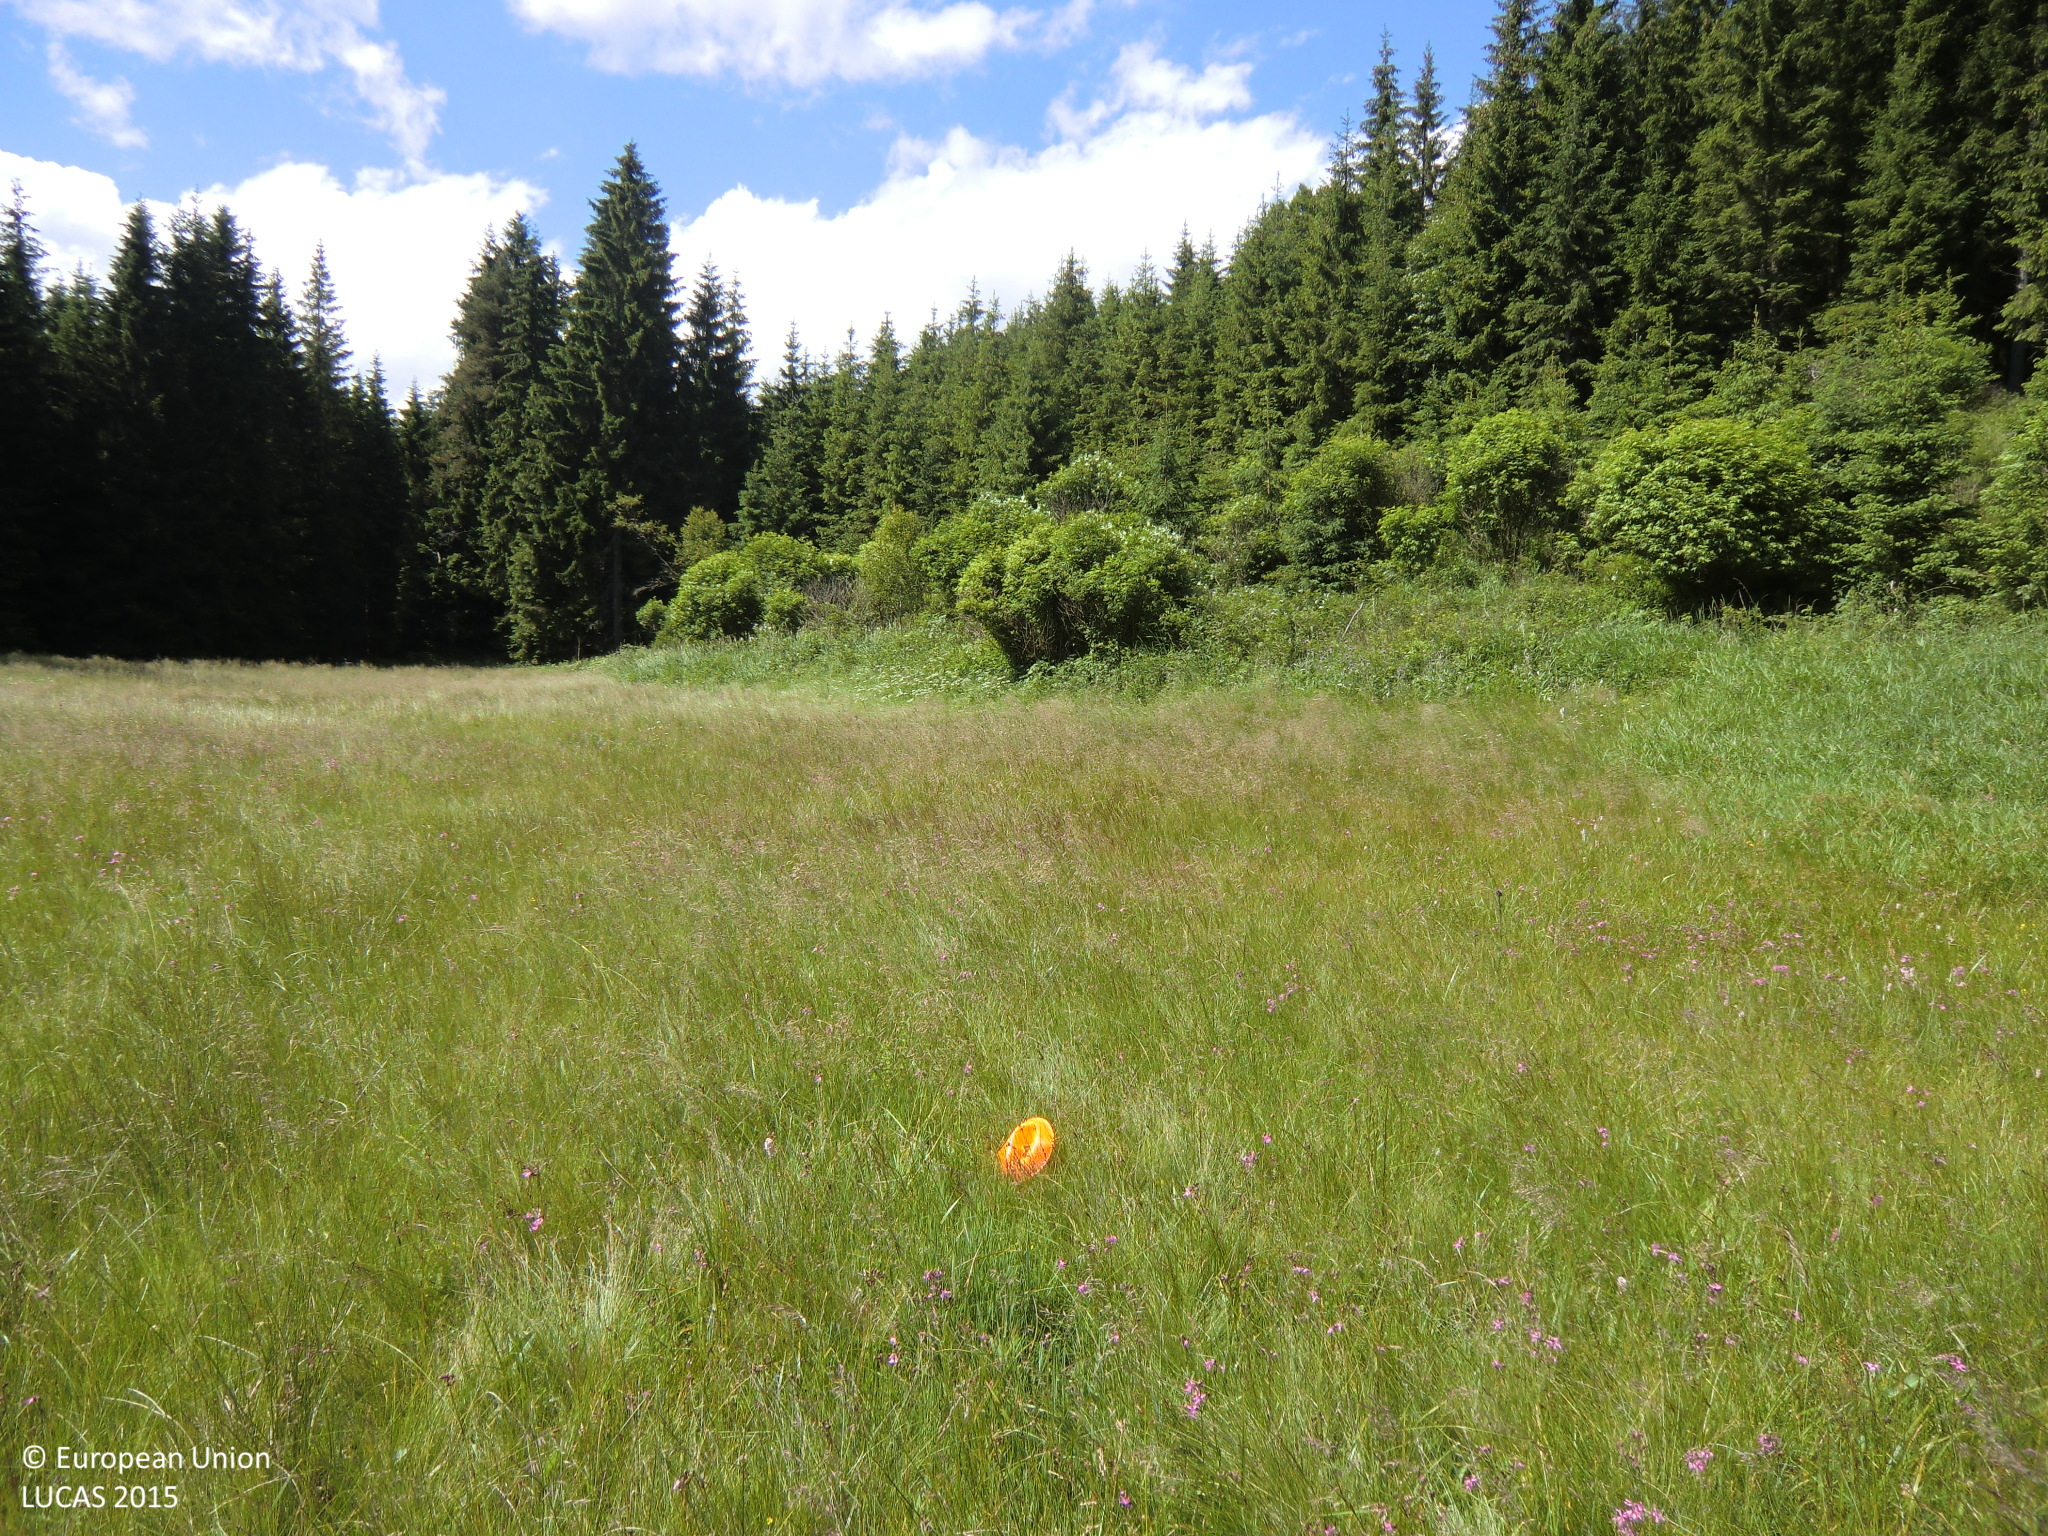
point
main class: Grassland
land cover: Grassland without tree/shrub cover
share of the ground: > 75 %
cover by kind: herbaceous plants 100 %
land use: Agriculture (excluding fallow land and kitchen gardens)
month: June
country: AT
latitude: 48.5199
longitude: 14.6991
